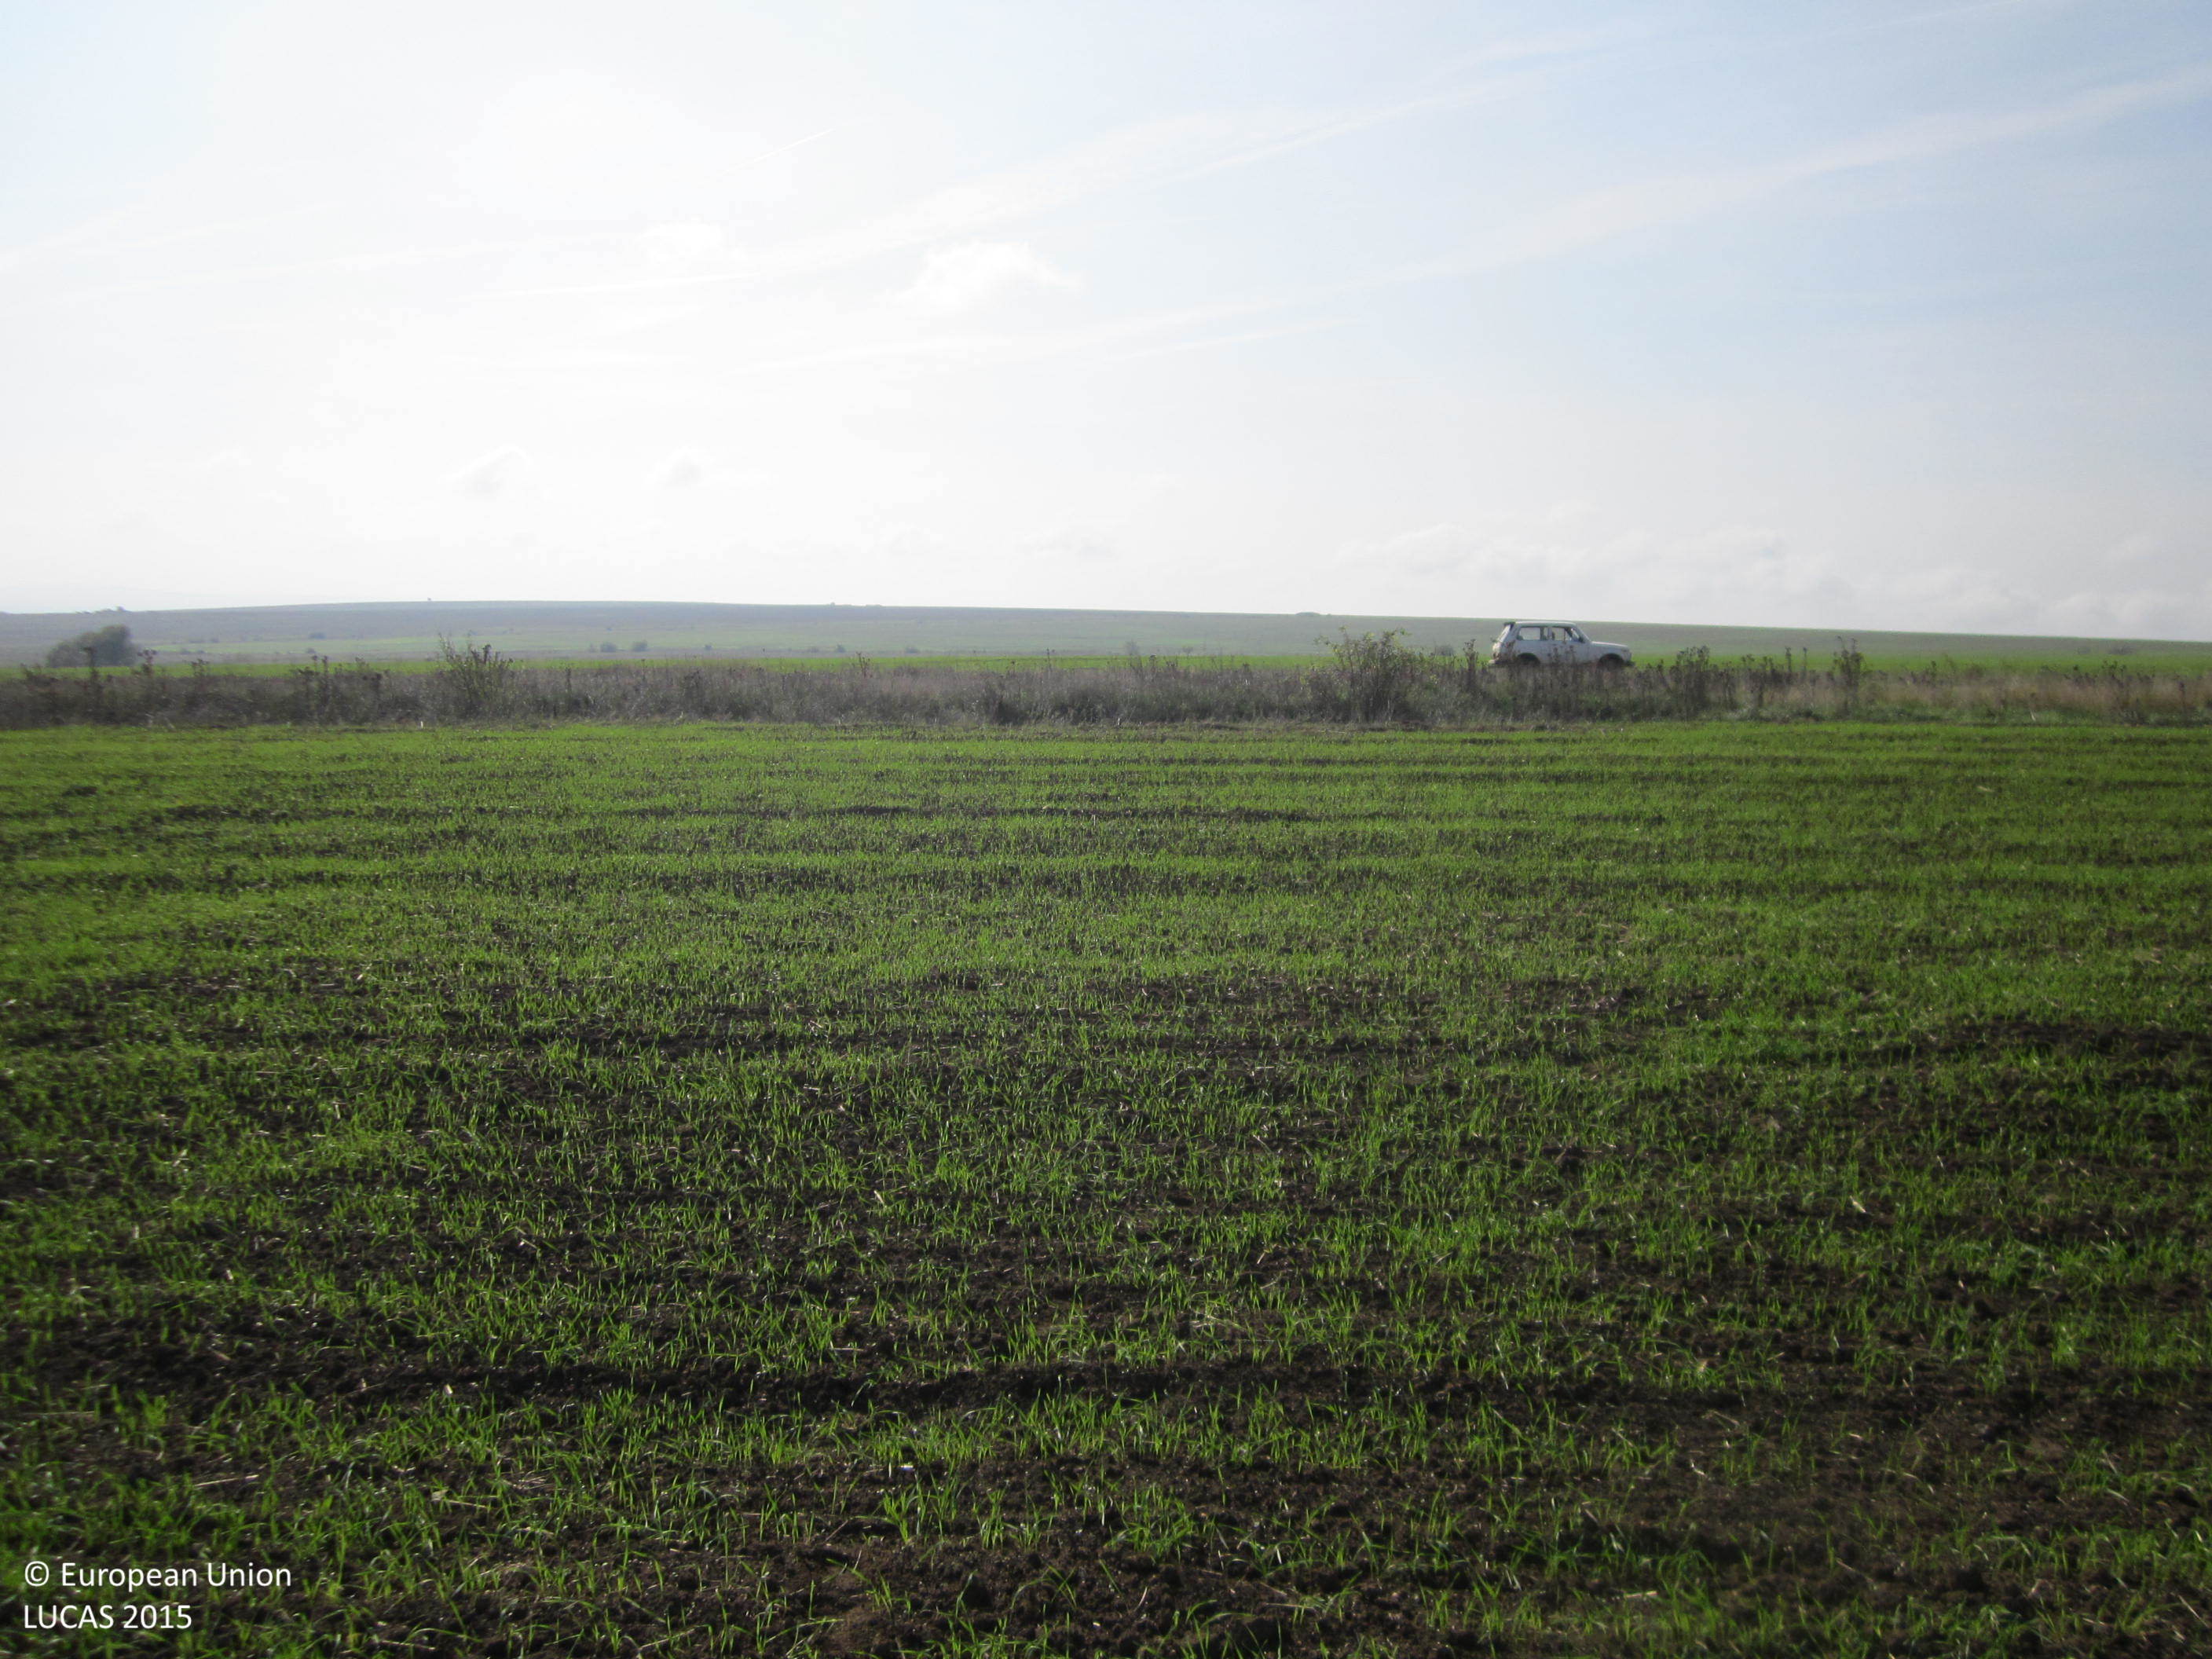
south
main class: Cropland
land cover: Common wheat
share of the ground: 25 - 50 %
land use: Agriculture (excluding fallow land and kitchen gardens)
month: October
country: BG
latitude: 42.6909
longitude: 26.8120
